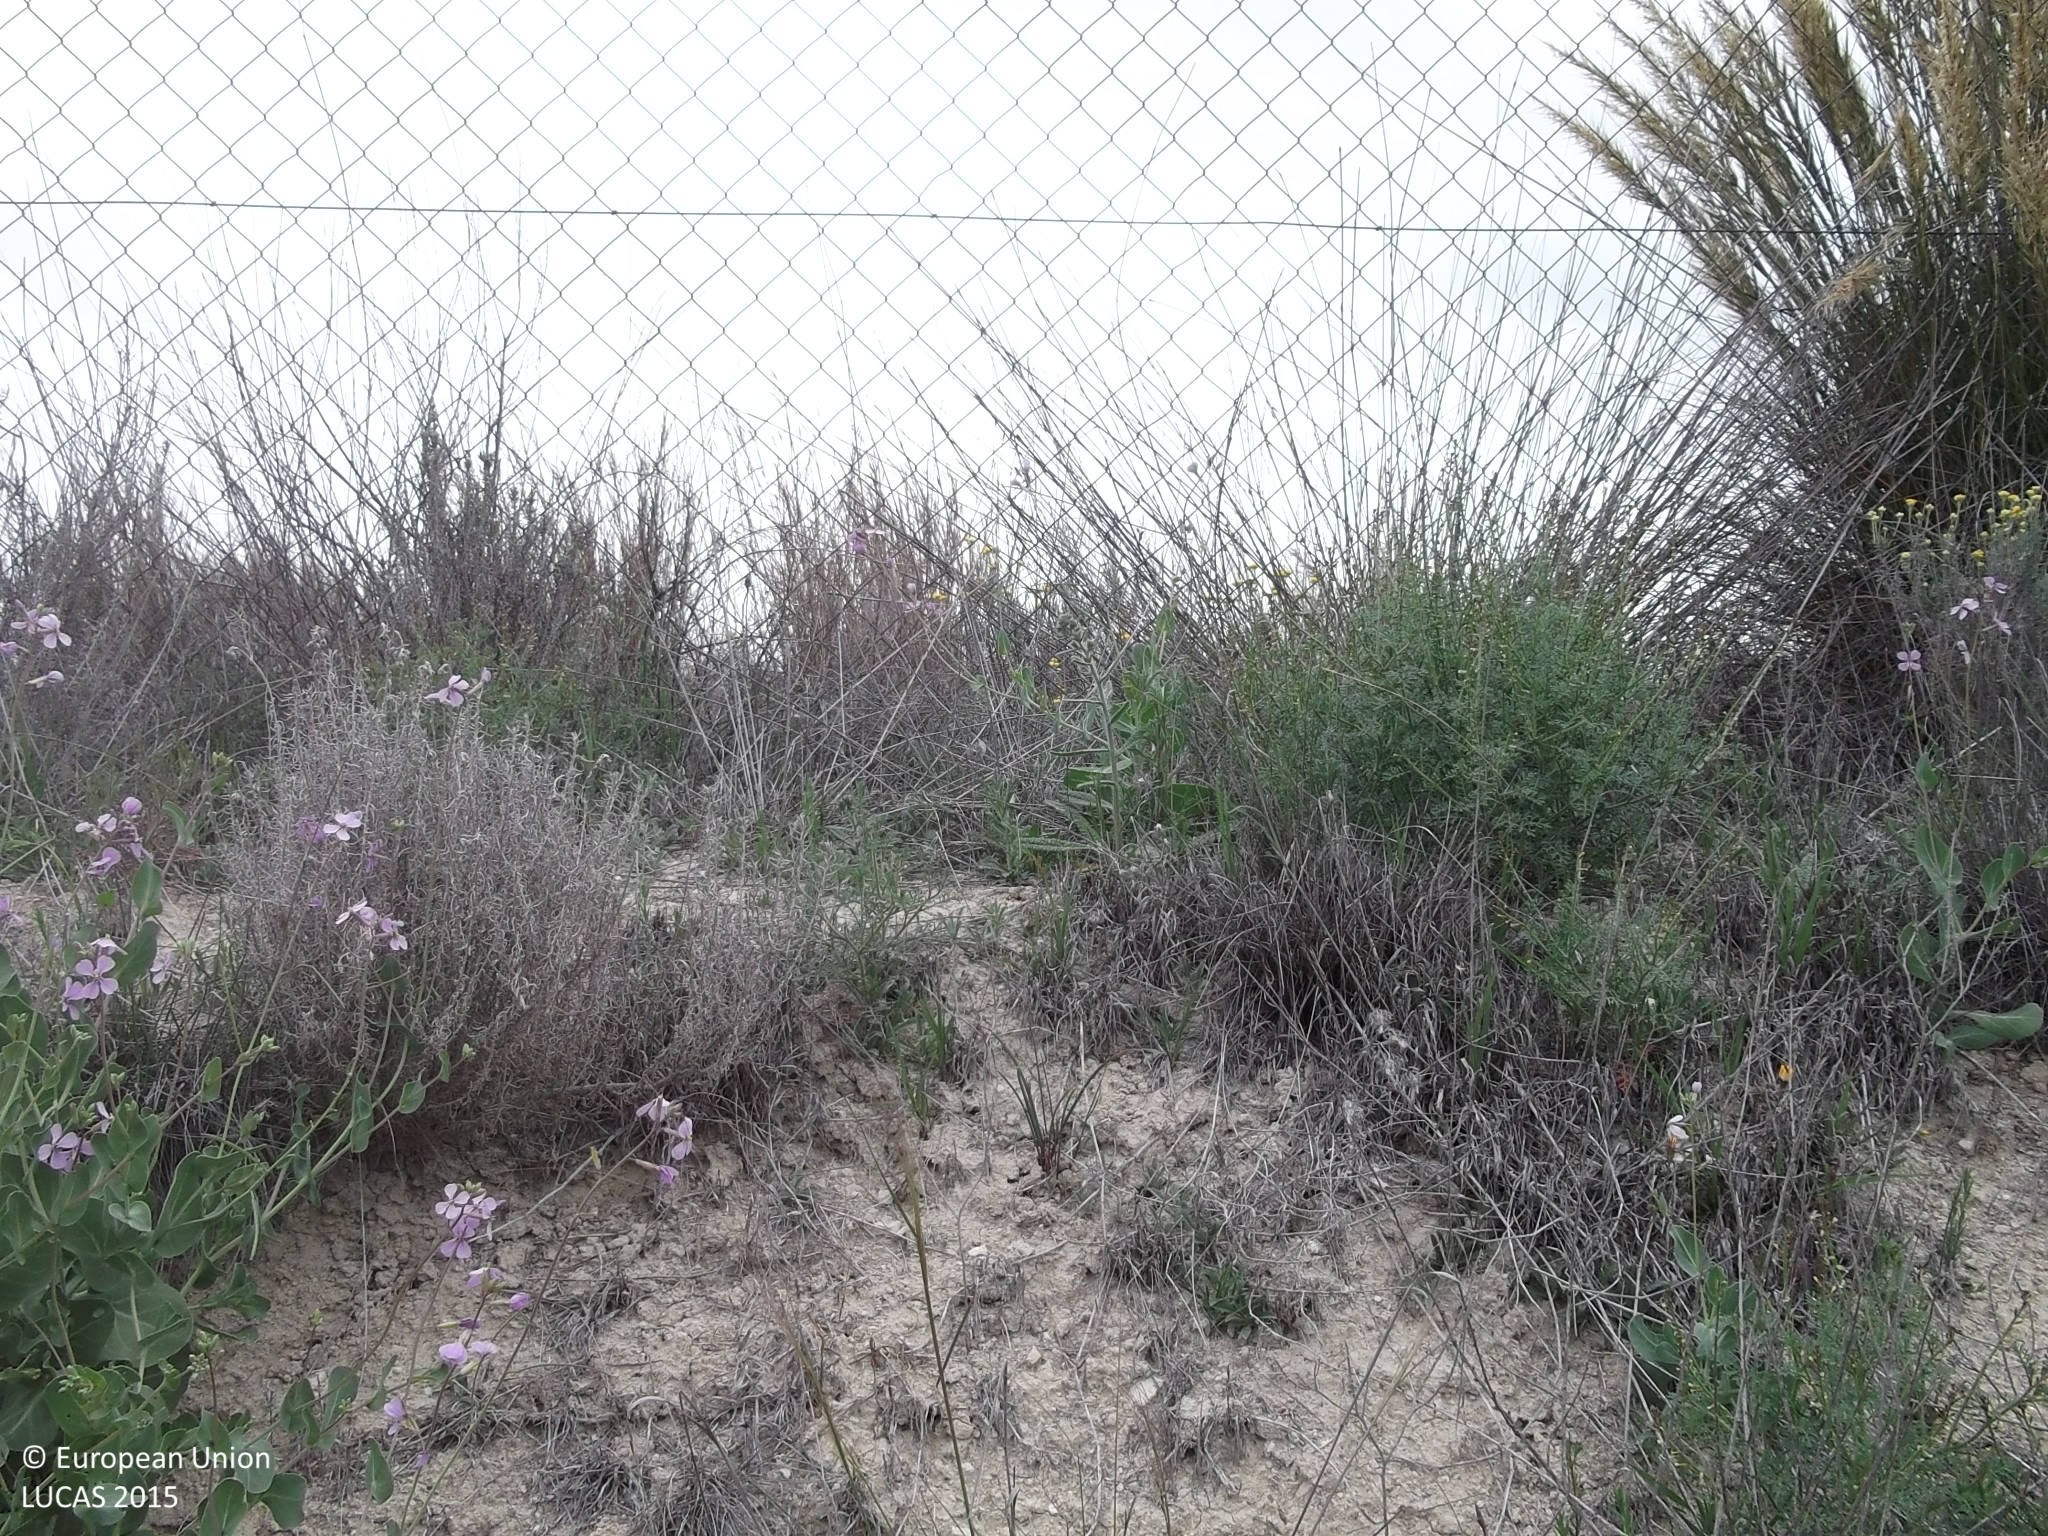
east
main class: Grassland
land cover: Grassland without tree/shrub cover
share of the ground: 10 - 25 %
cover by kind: consolidated bare surface 70 %, herbaceous plants 30 %
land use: Abandoned areas
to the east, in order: Grassland without tree/shrub cover; Paved roads, cycling and walking lanes; Grass margins; Nuts trees; Grass margins; Nuts trees; Other bare soil; Grass margins; Fences; Nuts trees; Other fresh vegetables; Artificial constructions in urban areas
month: April
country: ES
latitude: 37.9729
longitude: -1.5631
